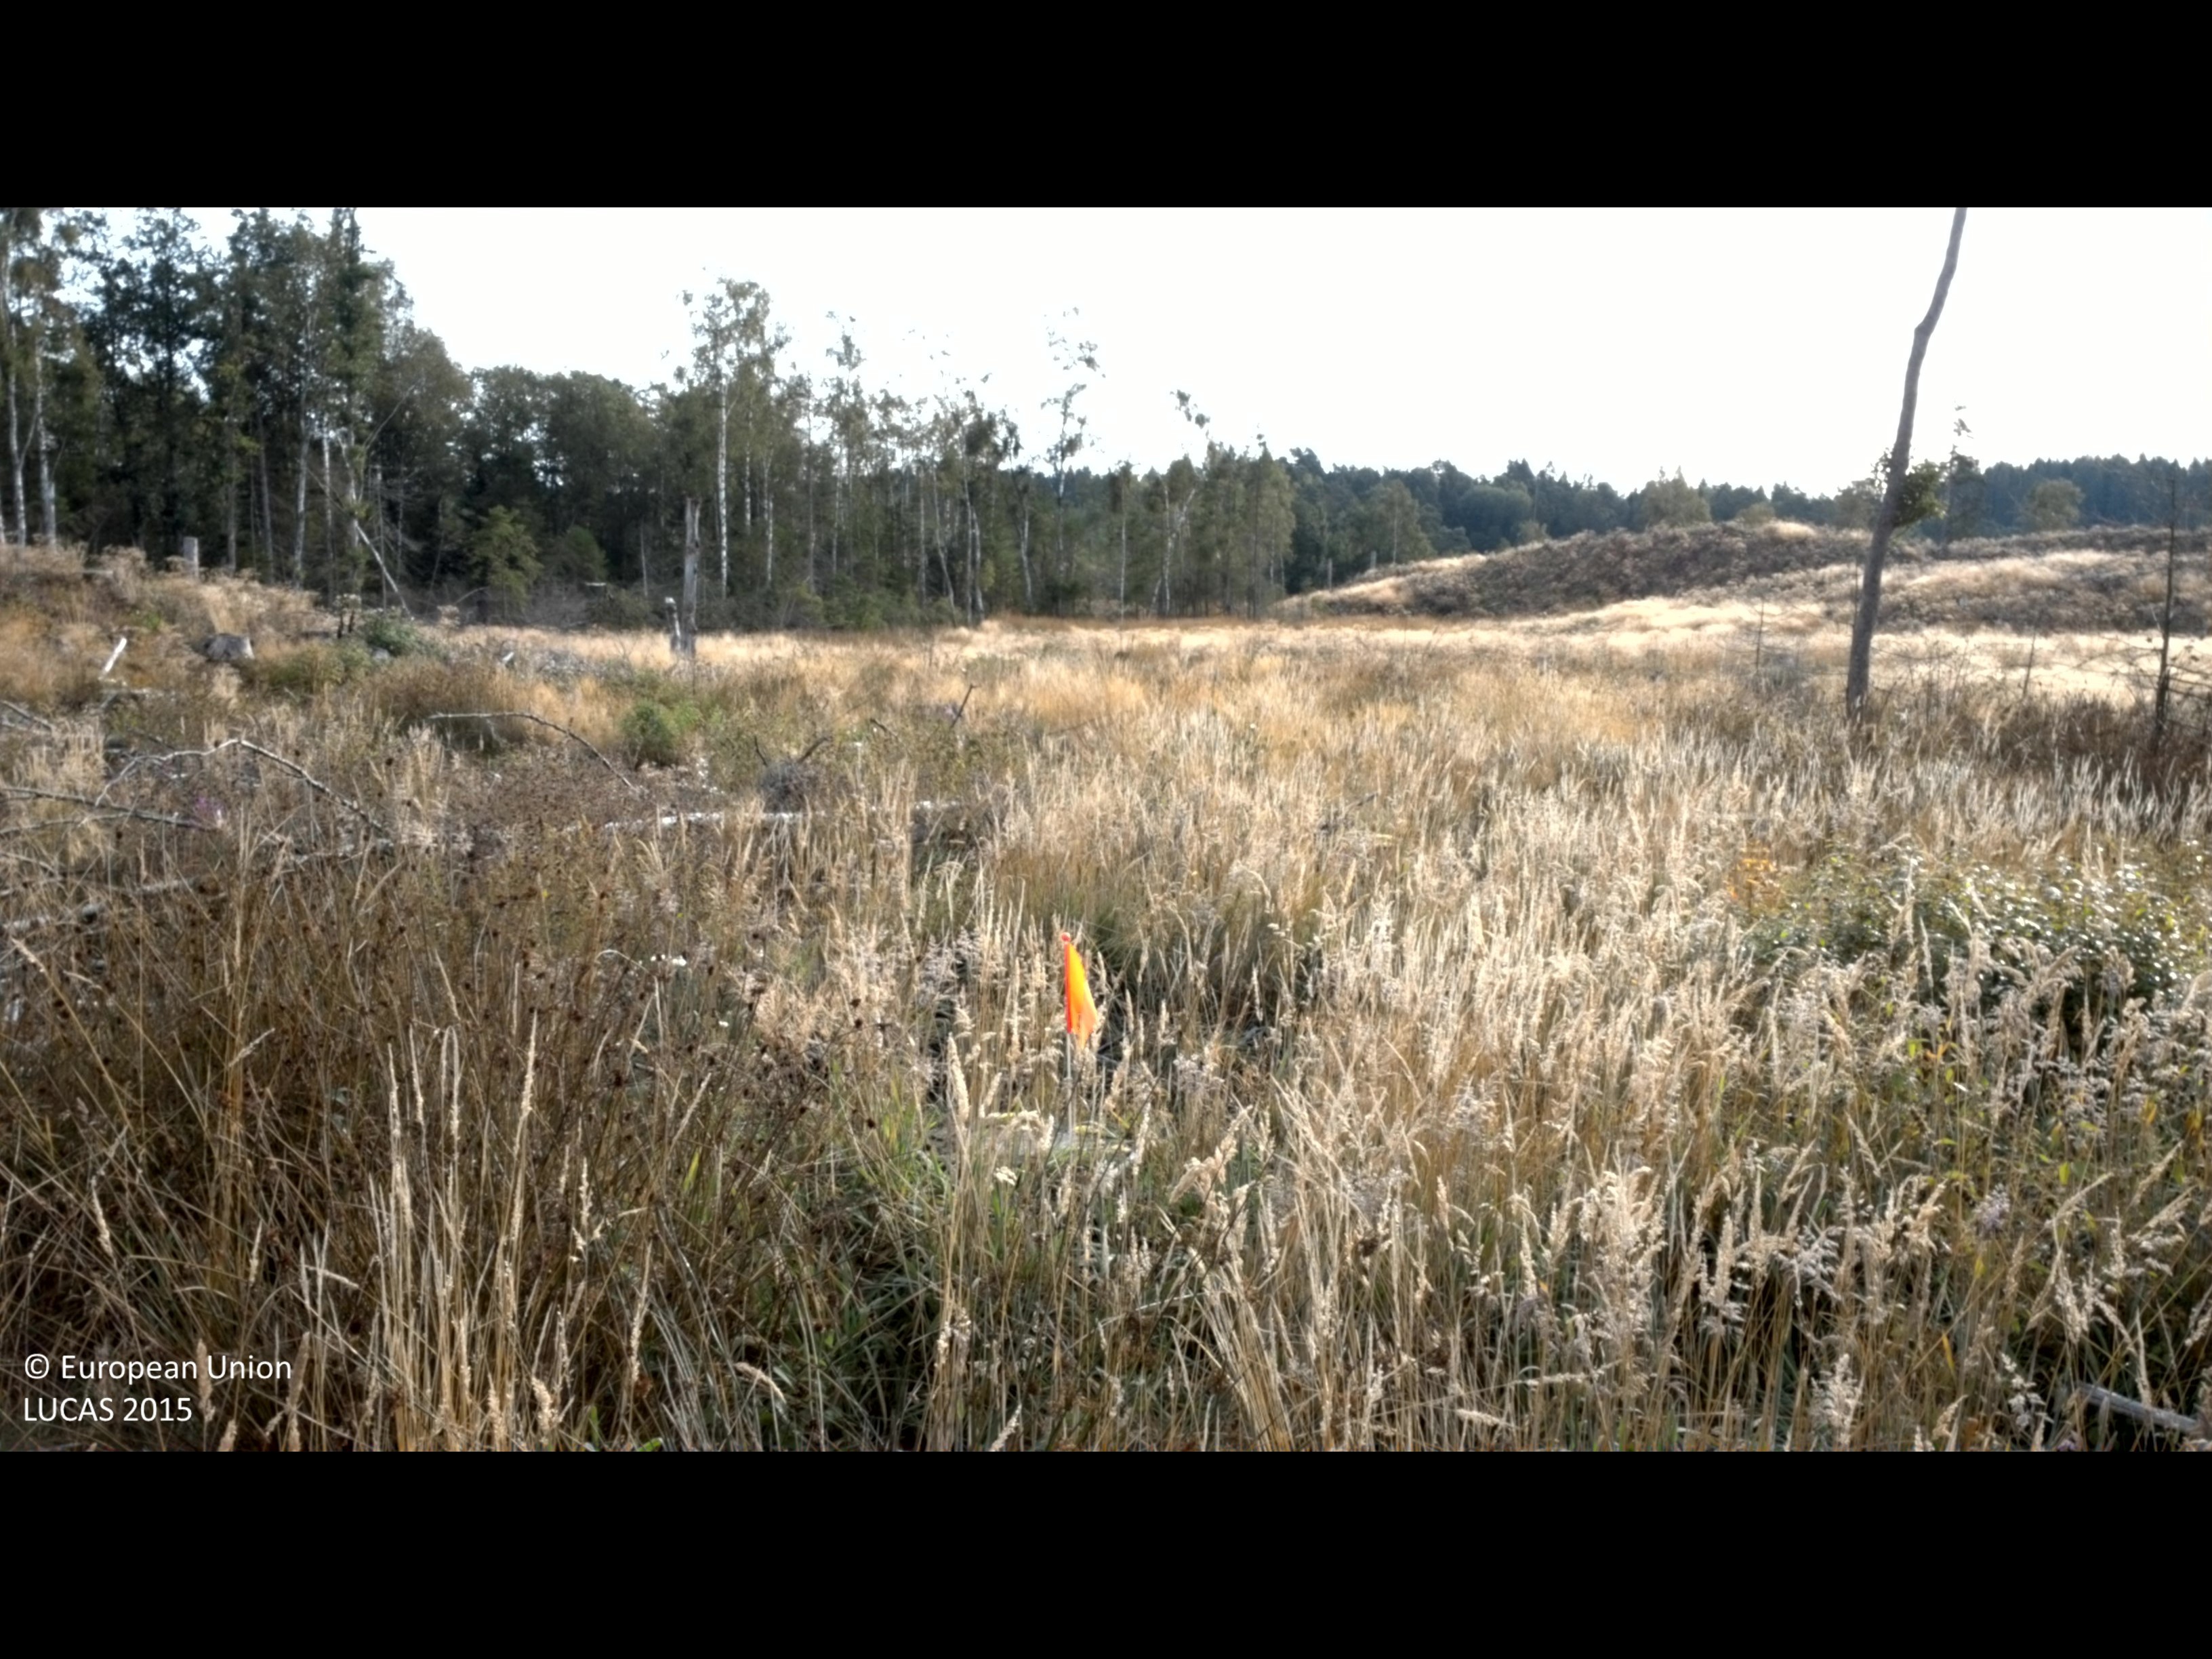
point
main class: Grassland
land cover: Grassland with sparse tree/shrub cover
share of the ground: > 75 %
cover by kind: herbaceous plants 90 %, broadleaved forest trees 5 %, shrubs 5 %
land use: Forestry
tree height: > 5 m
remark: Clear cut
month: September
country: SE
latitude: 56.9486
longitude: 12.8079
